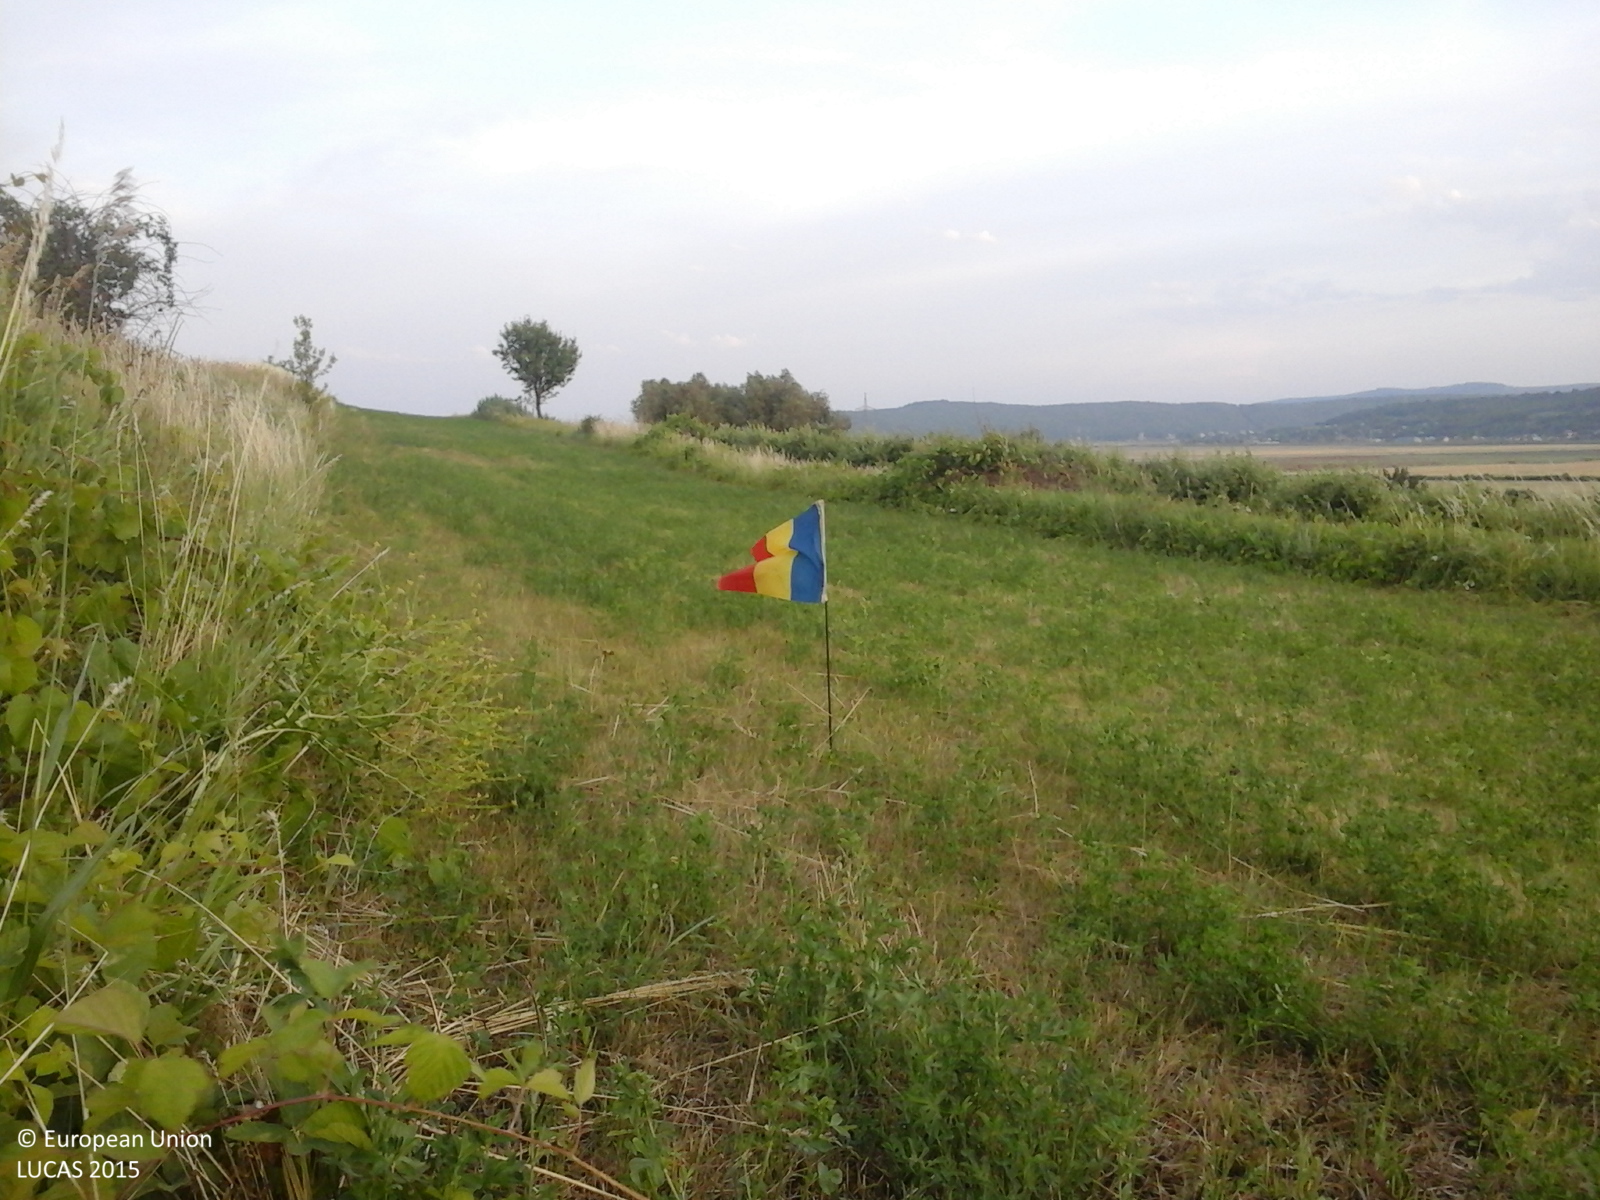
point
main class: Cropland
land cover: Lucerne
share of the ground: > 75 %
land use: Agriculture (excluding fallow land and kitchen gardens)
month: June
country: RO
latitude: 46.6657
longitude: 27.6972
